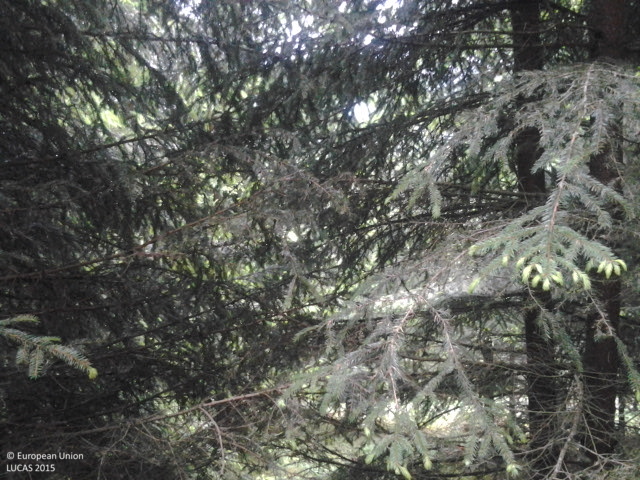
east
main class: Woodland
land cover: Spruce dominated coniferous woodland
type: alpine coniferous forest
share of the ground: > 75 %
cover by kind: coniferous forest trees 100 %
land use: Forestry
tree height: > 5 m
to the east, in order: Spruce dominated coniferous woodland; Fences; Grassland without tree/shrub cover; Artificial constructions in urban areas; Other fruit trees and berries; Fences; Grass margins; Tracks; Grass margins; Fences; Electric lines; Grassland without tree/shrub cover; Ditches and canals; Grassland without tree/shrub cover
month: June
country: RO
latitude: 47.3034
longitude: 25.3610
